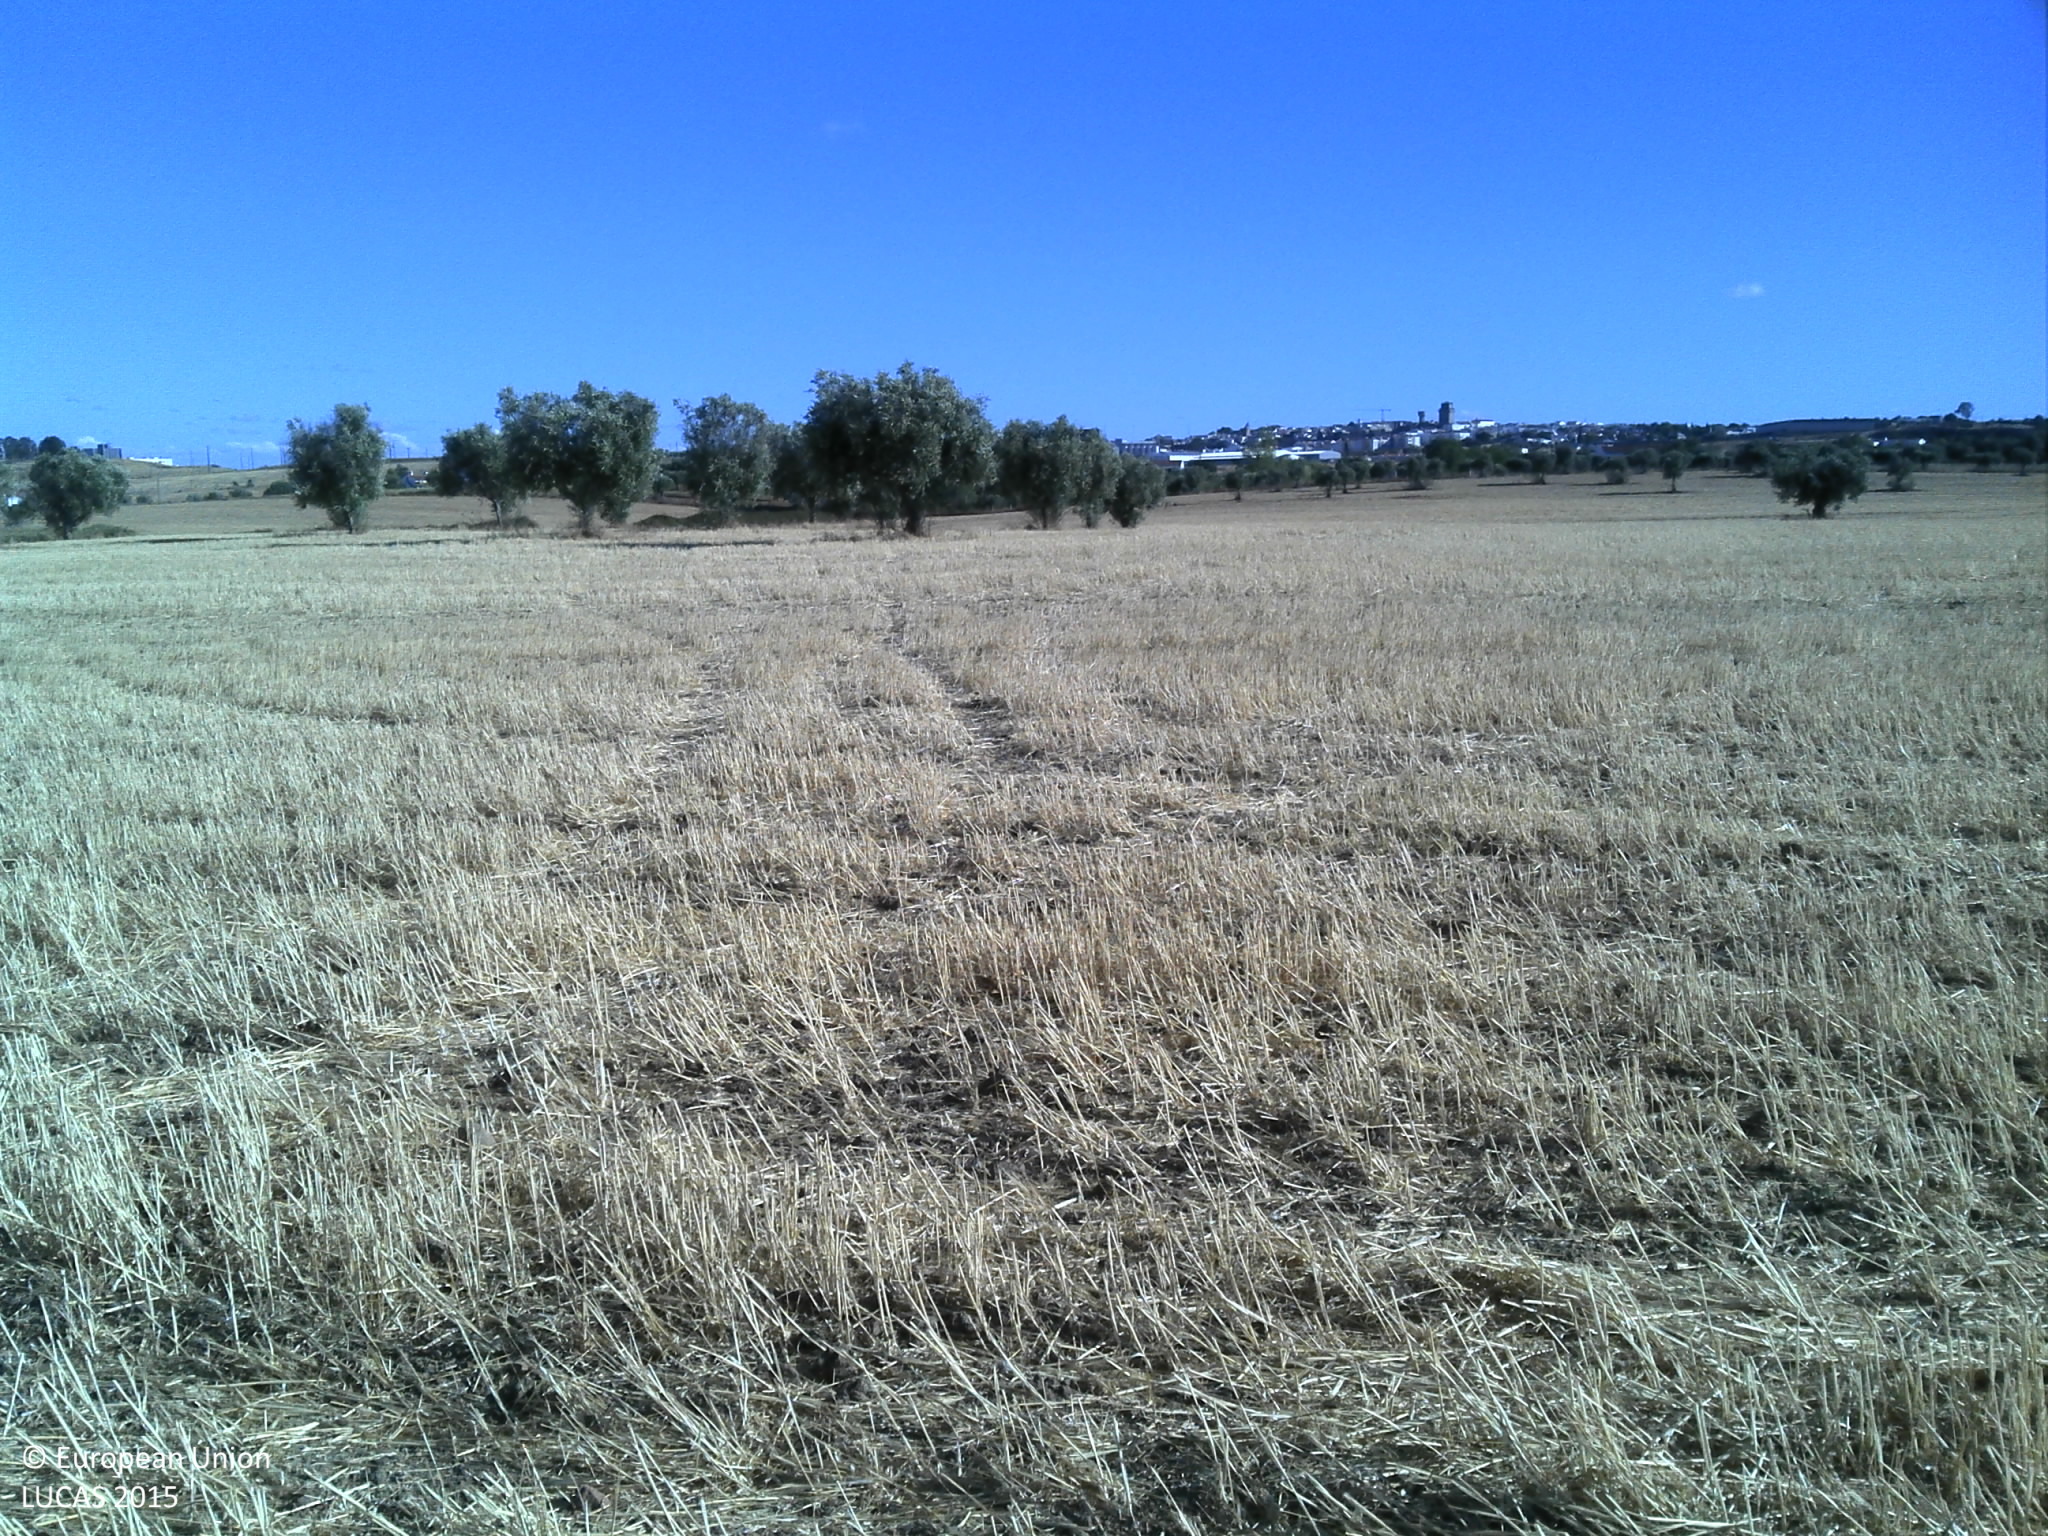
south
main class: Cropland
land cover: Barley
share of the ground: > 75 %
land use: Agriculture (excluding fallow land and kitchen gardens)
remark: Harvested field
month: July
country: PT
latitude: 38.0404
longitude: -7.8601
